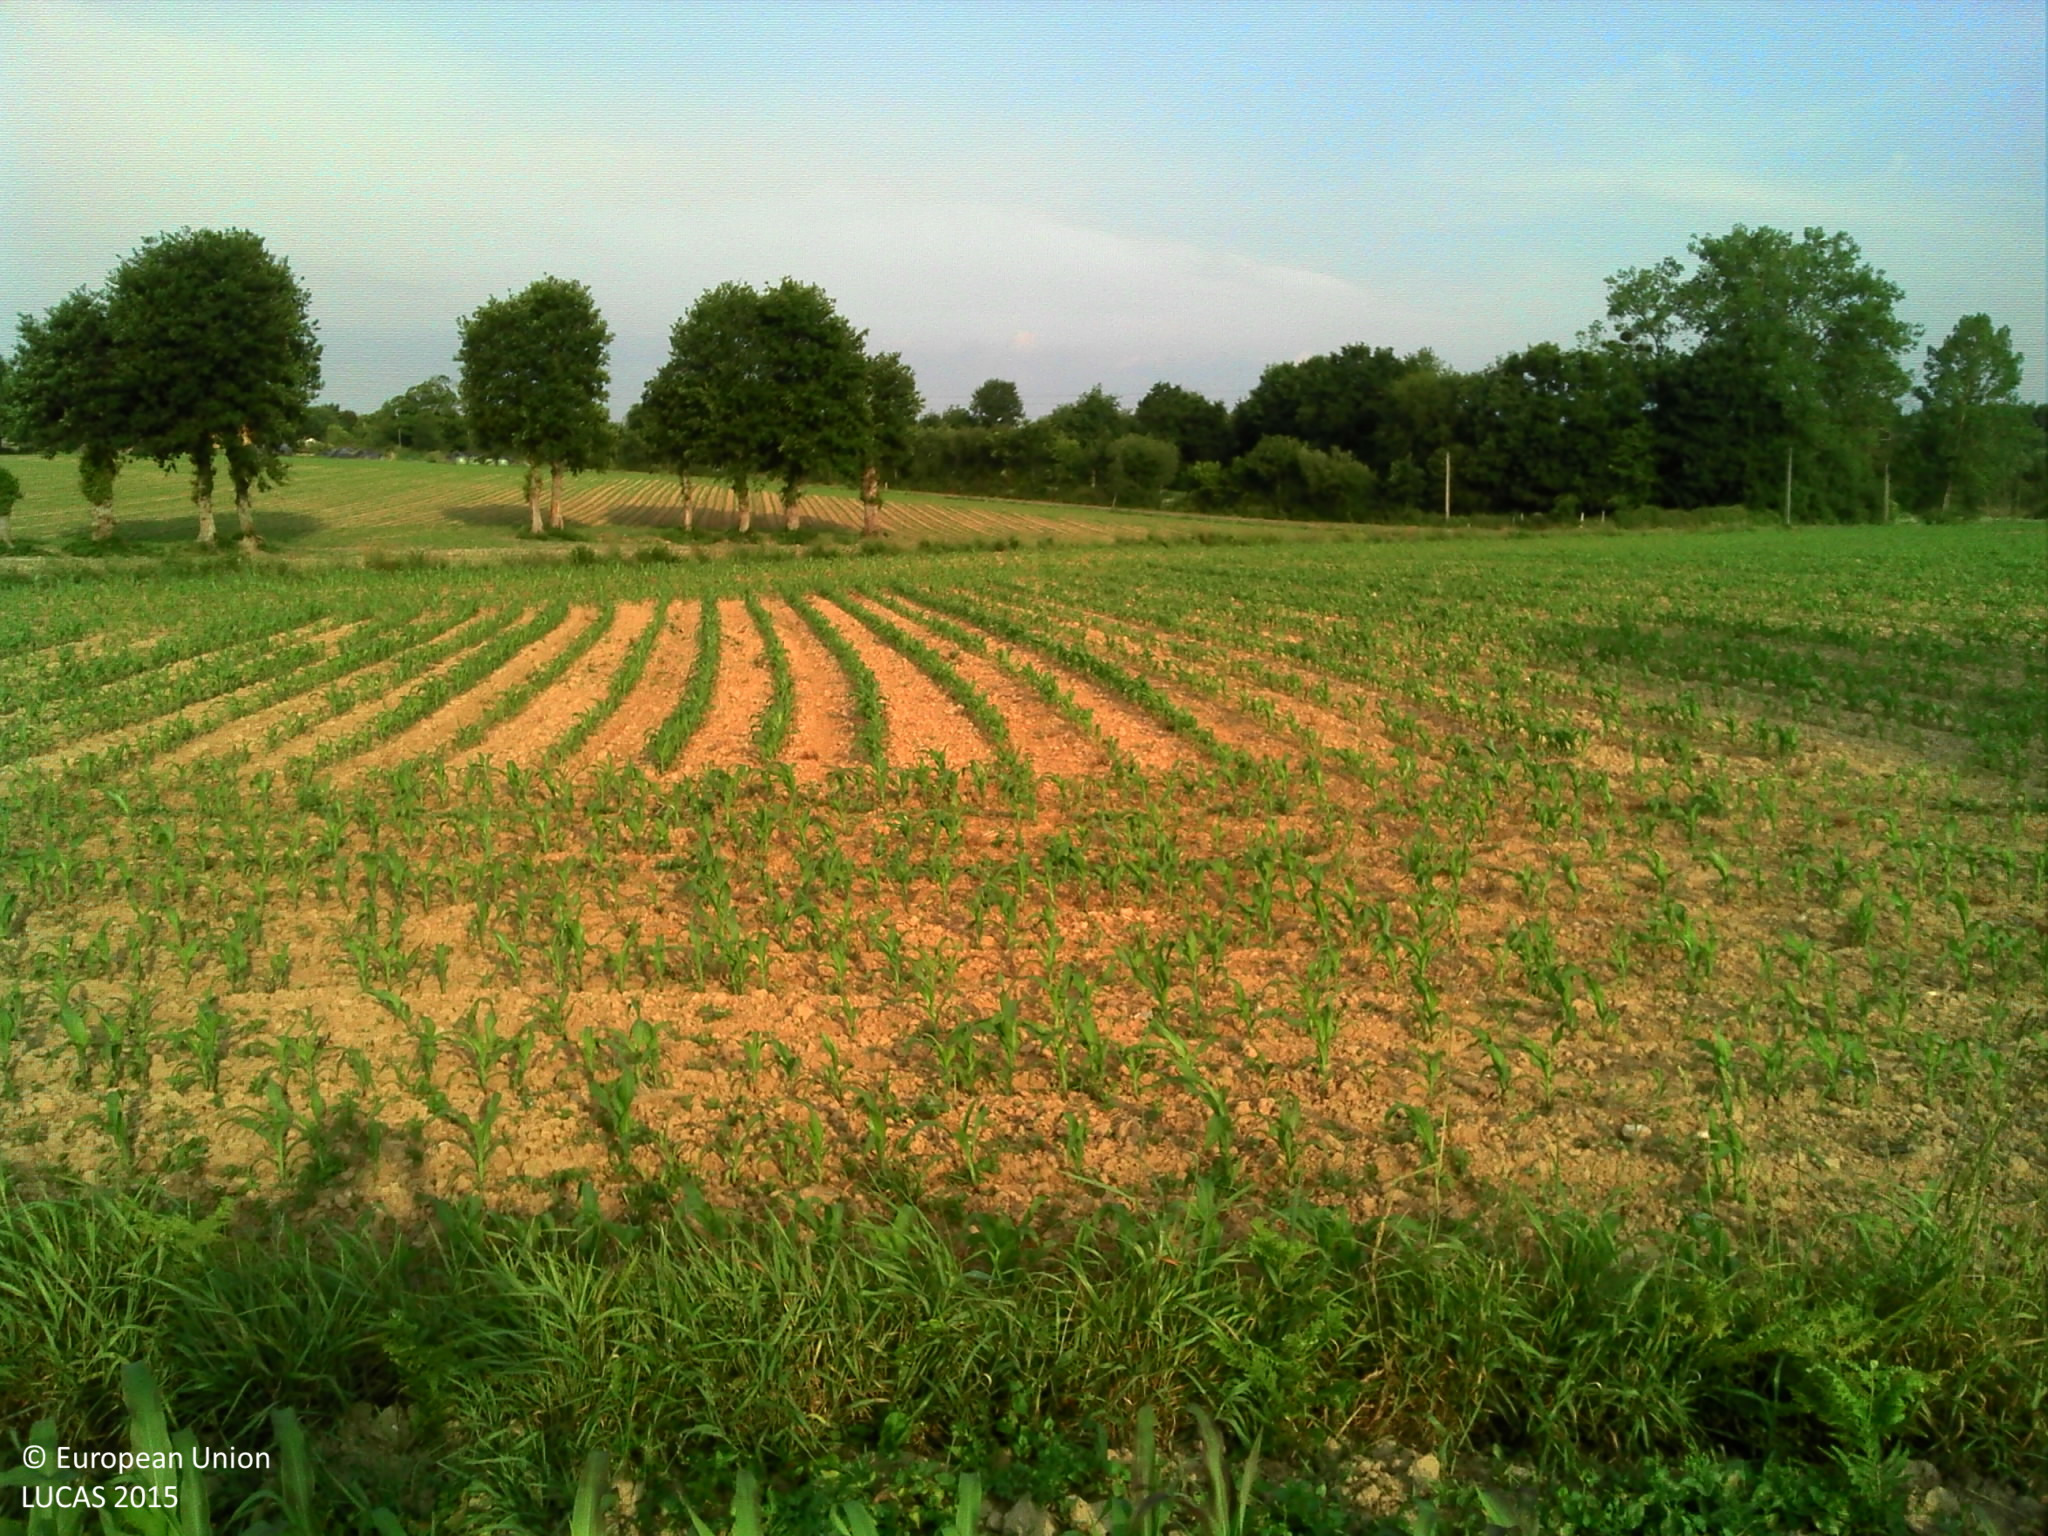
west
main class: Cropland
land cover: Maize
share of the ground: 25 - 50 %
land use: Agriculture (excluding fallow land and kitchen gardens)
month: June
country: FR
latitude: 48.1559
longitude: -1.9218
